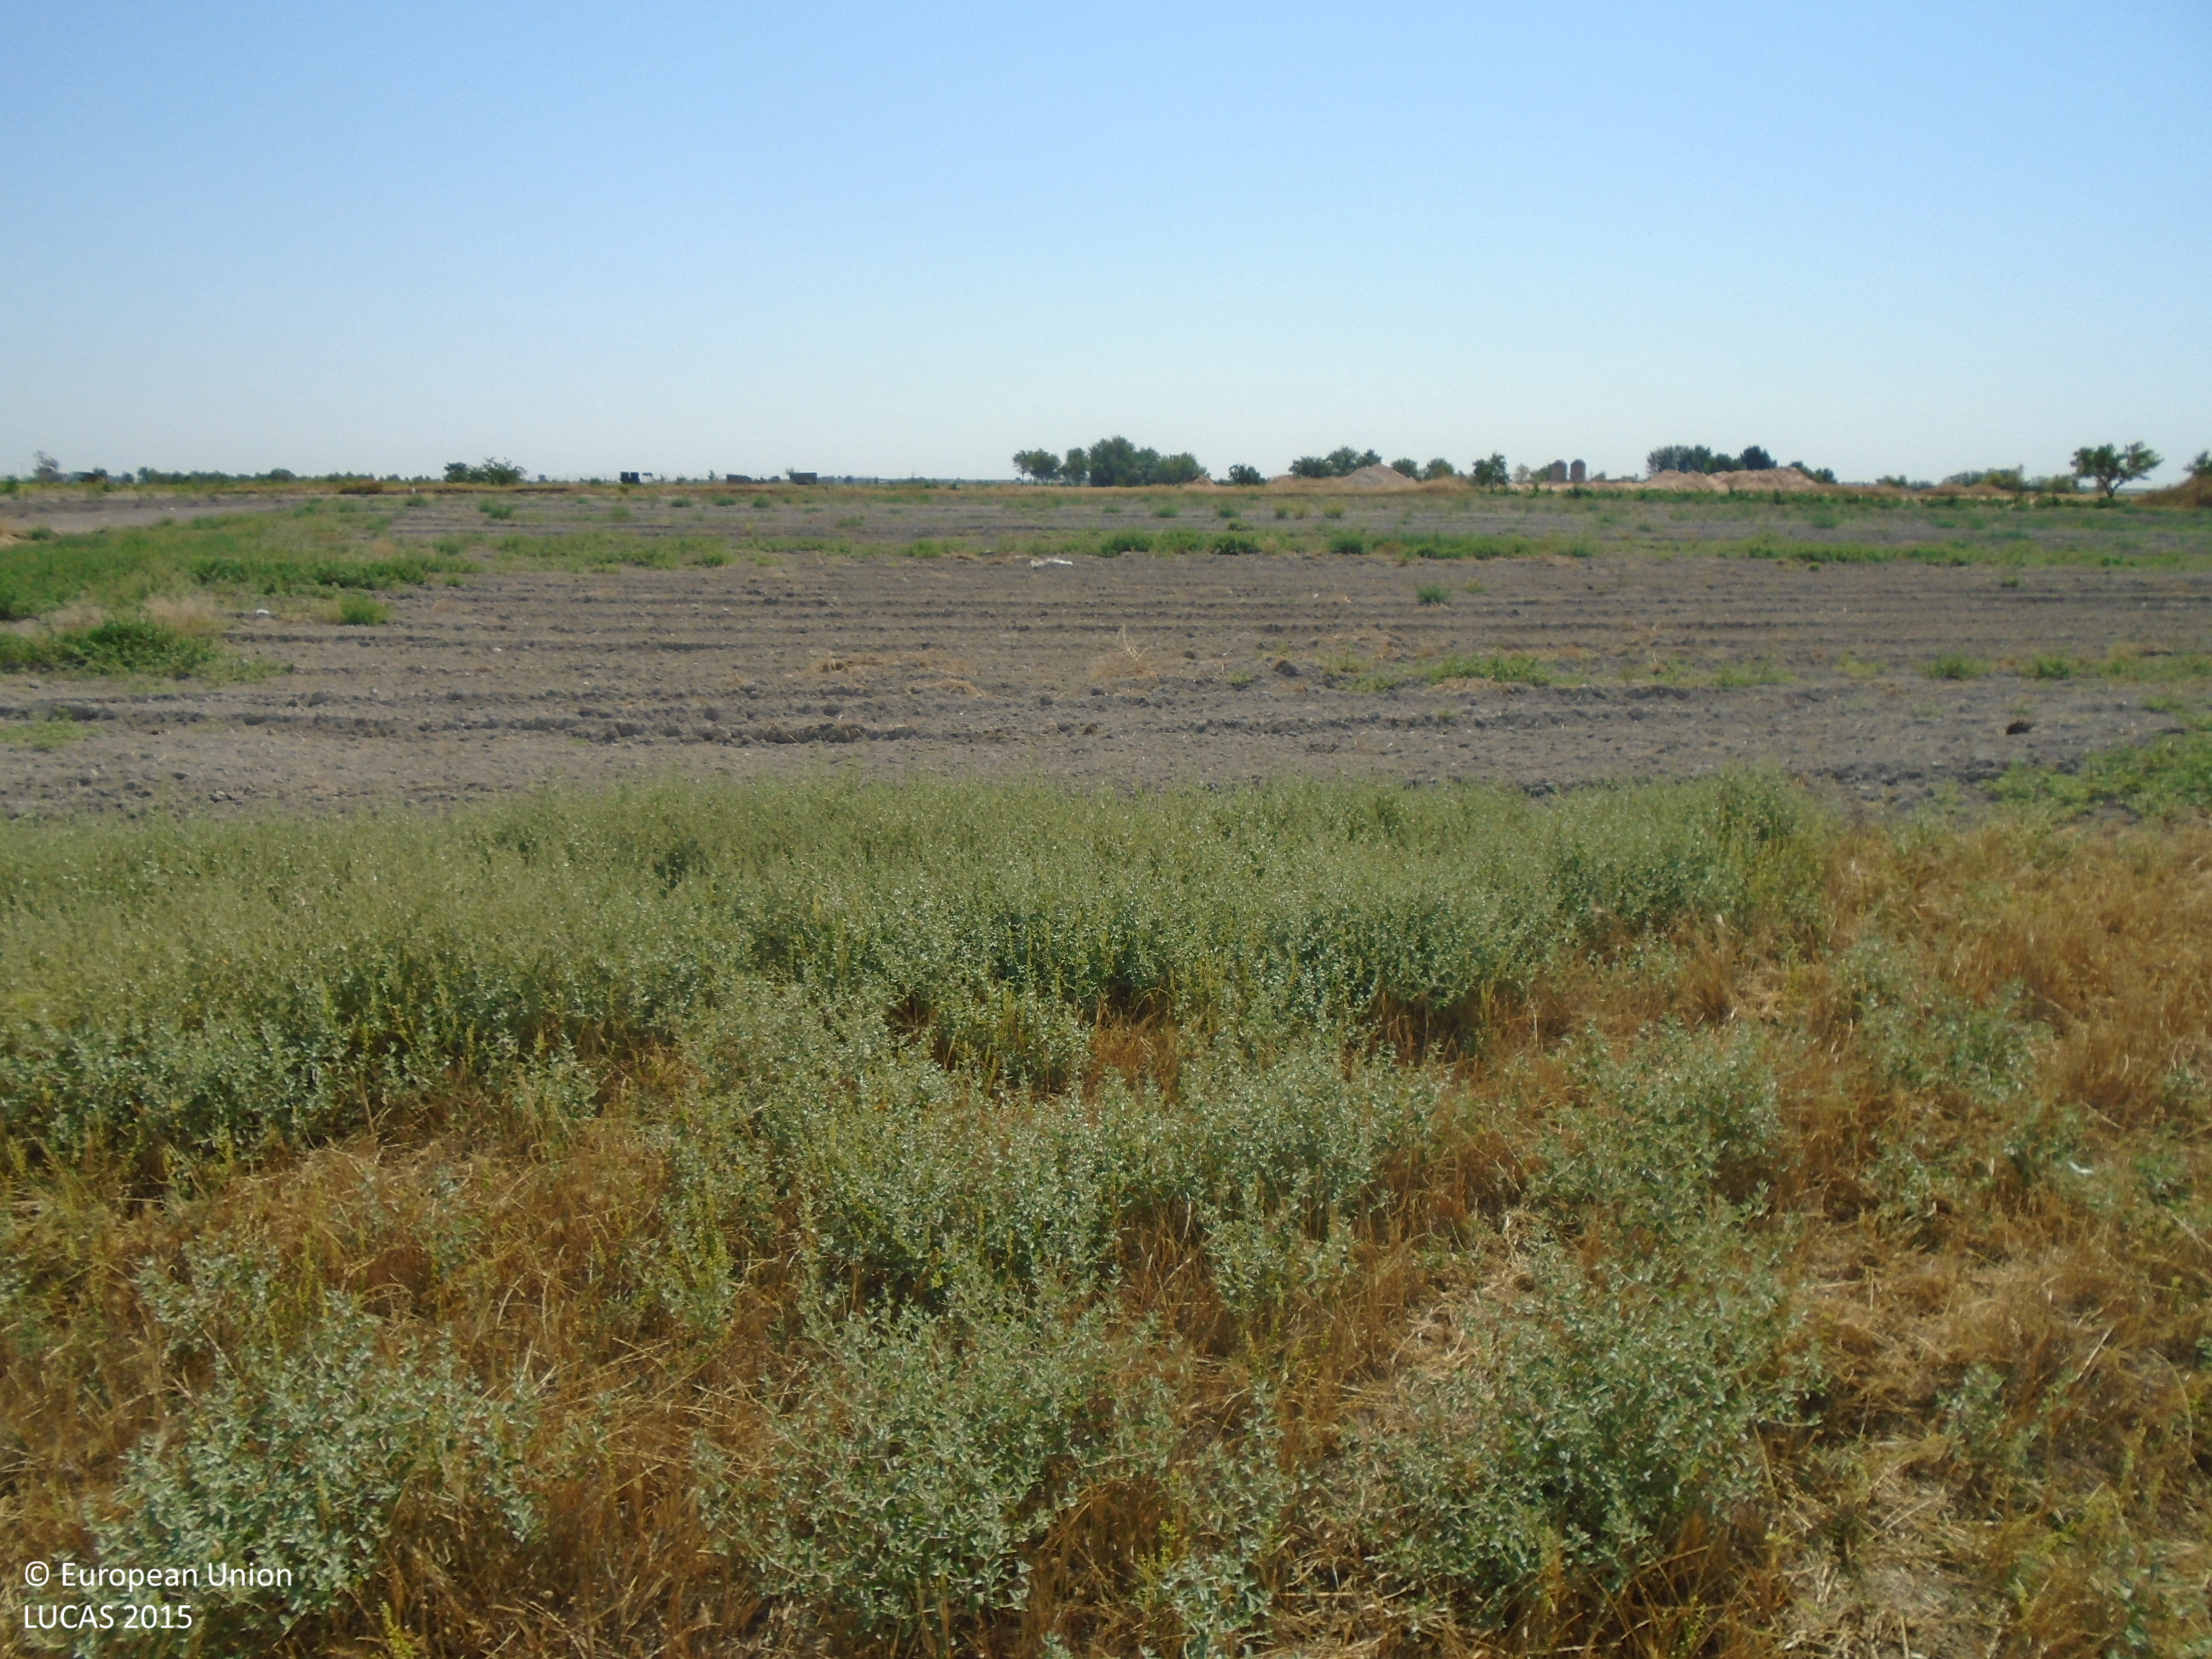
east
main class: Cropland
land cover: Barley
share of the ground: > 75 %
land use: Agriculture (excluding fallow land and kitchen gardens)
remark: Harvested field
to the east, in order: Barley; Grass margins; Other bare soil; Grassland without tree/shrub cover; Other bare soil; Vineyards; Tracks; Other bare soil; Tracks; Grassland without tree/shrub cover
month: June
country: ES
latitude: 39.1840
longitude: -3.6223
